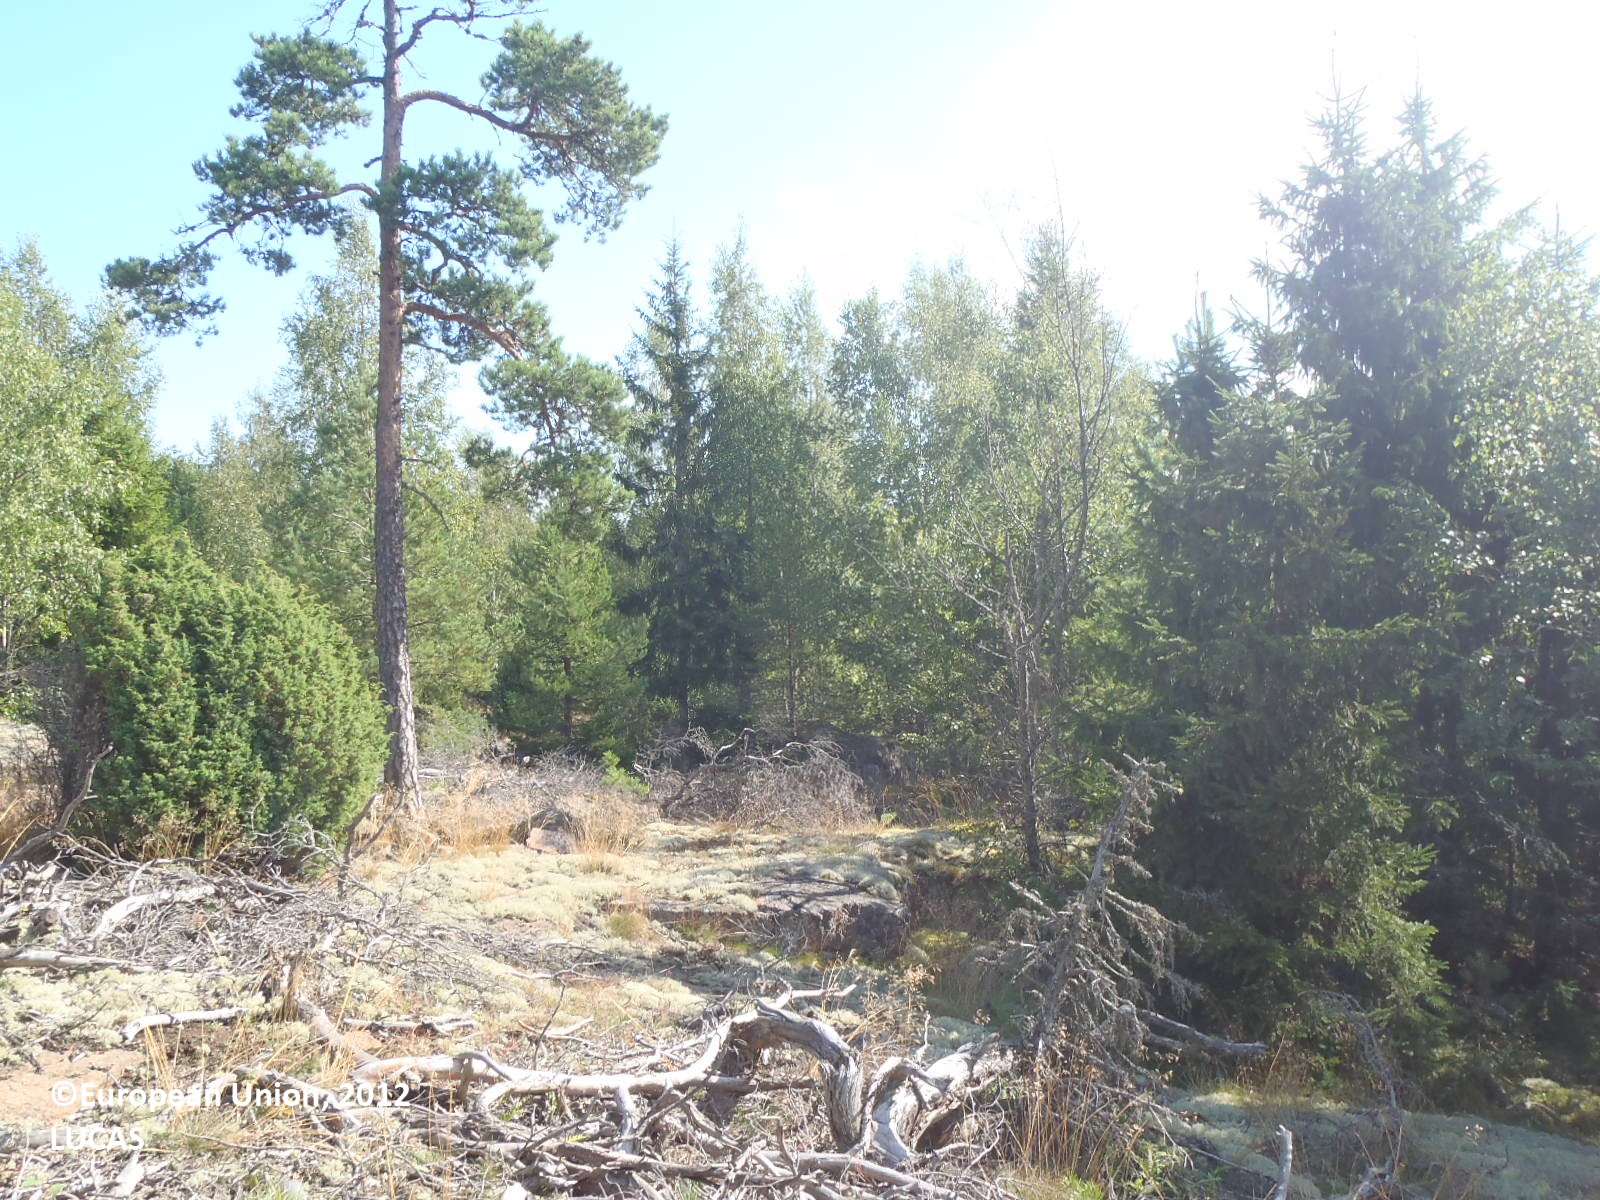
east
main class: Woodland
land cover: Pine dominated mixed woodland
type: hemiboreal forest and nemoral coniferous forest and mixed broadleaved-coniferous forest
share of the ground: 50 - 75 %
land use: Forestry
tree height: > 5 m
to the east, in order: Pine dominated mixed woodland; Lichens and moss; Pine dominated mixed woodland; Grassland with sparse tree/shrub cover; Electric lines; Grassland with sparse tree/shrub cover; Ditches and canals; Grass margins; Temporary grasslands; Grass margins; Ditches and canals; Grass margins; Pine dominated mixed woodland; Pine dominated coniferous woodland
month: August
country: FI
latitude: 60.2526
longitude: 20.3627
